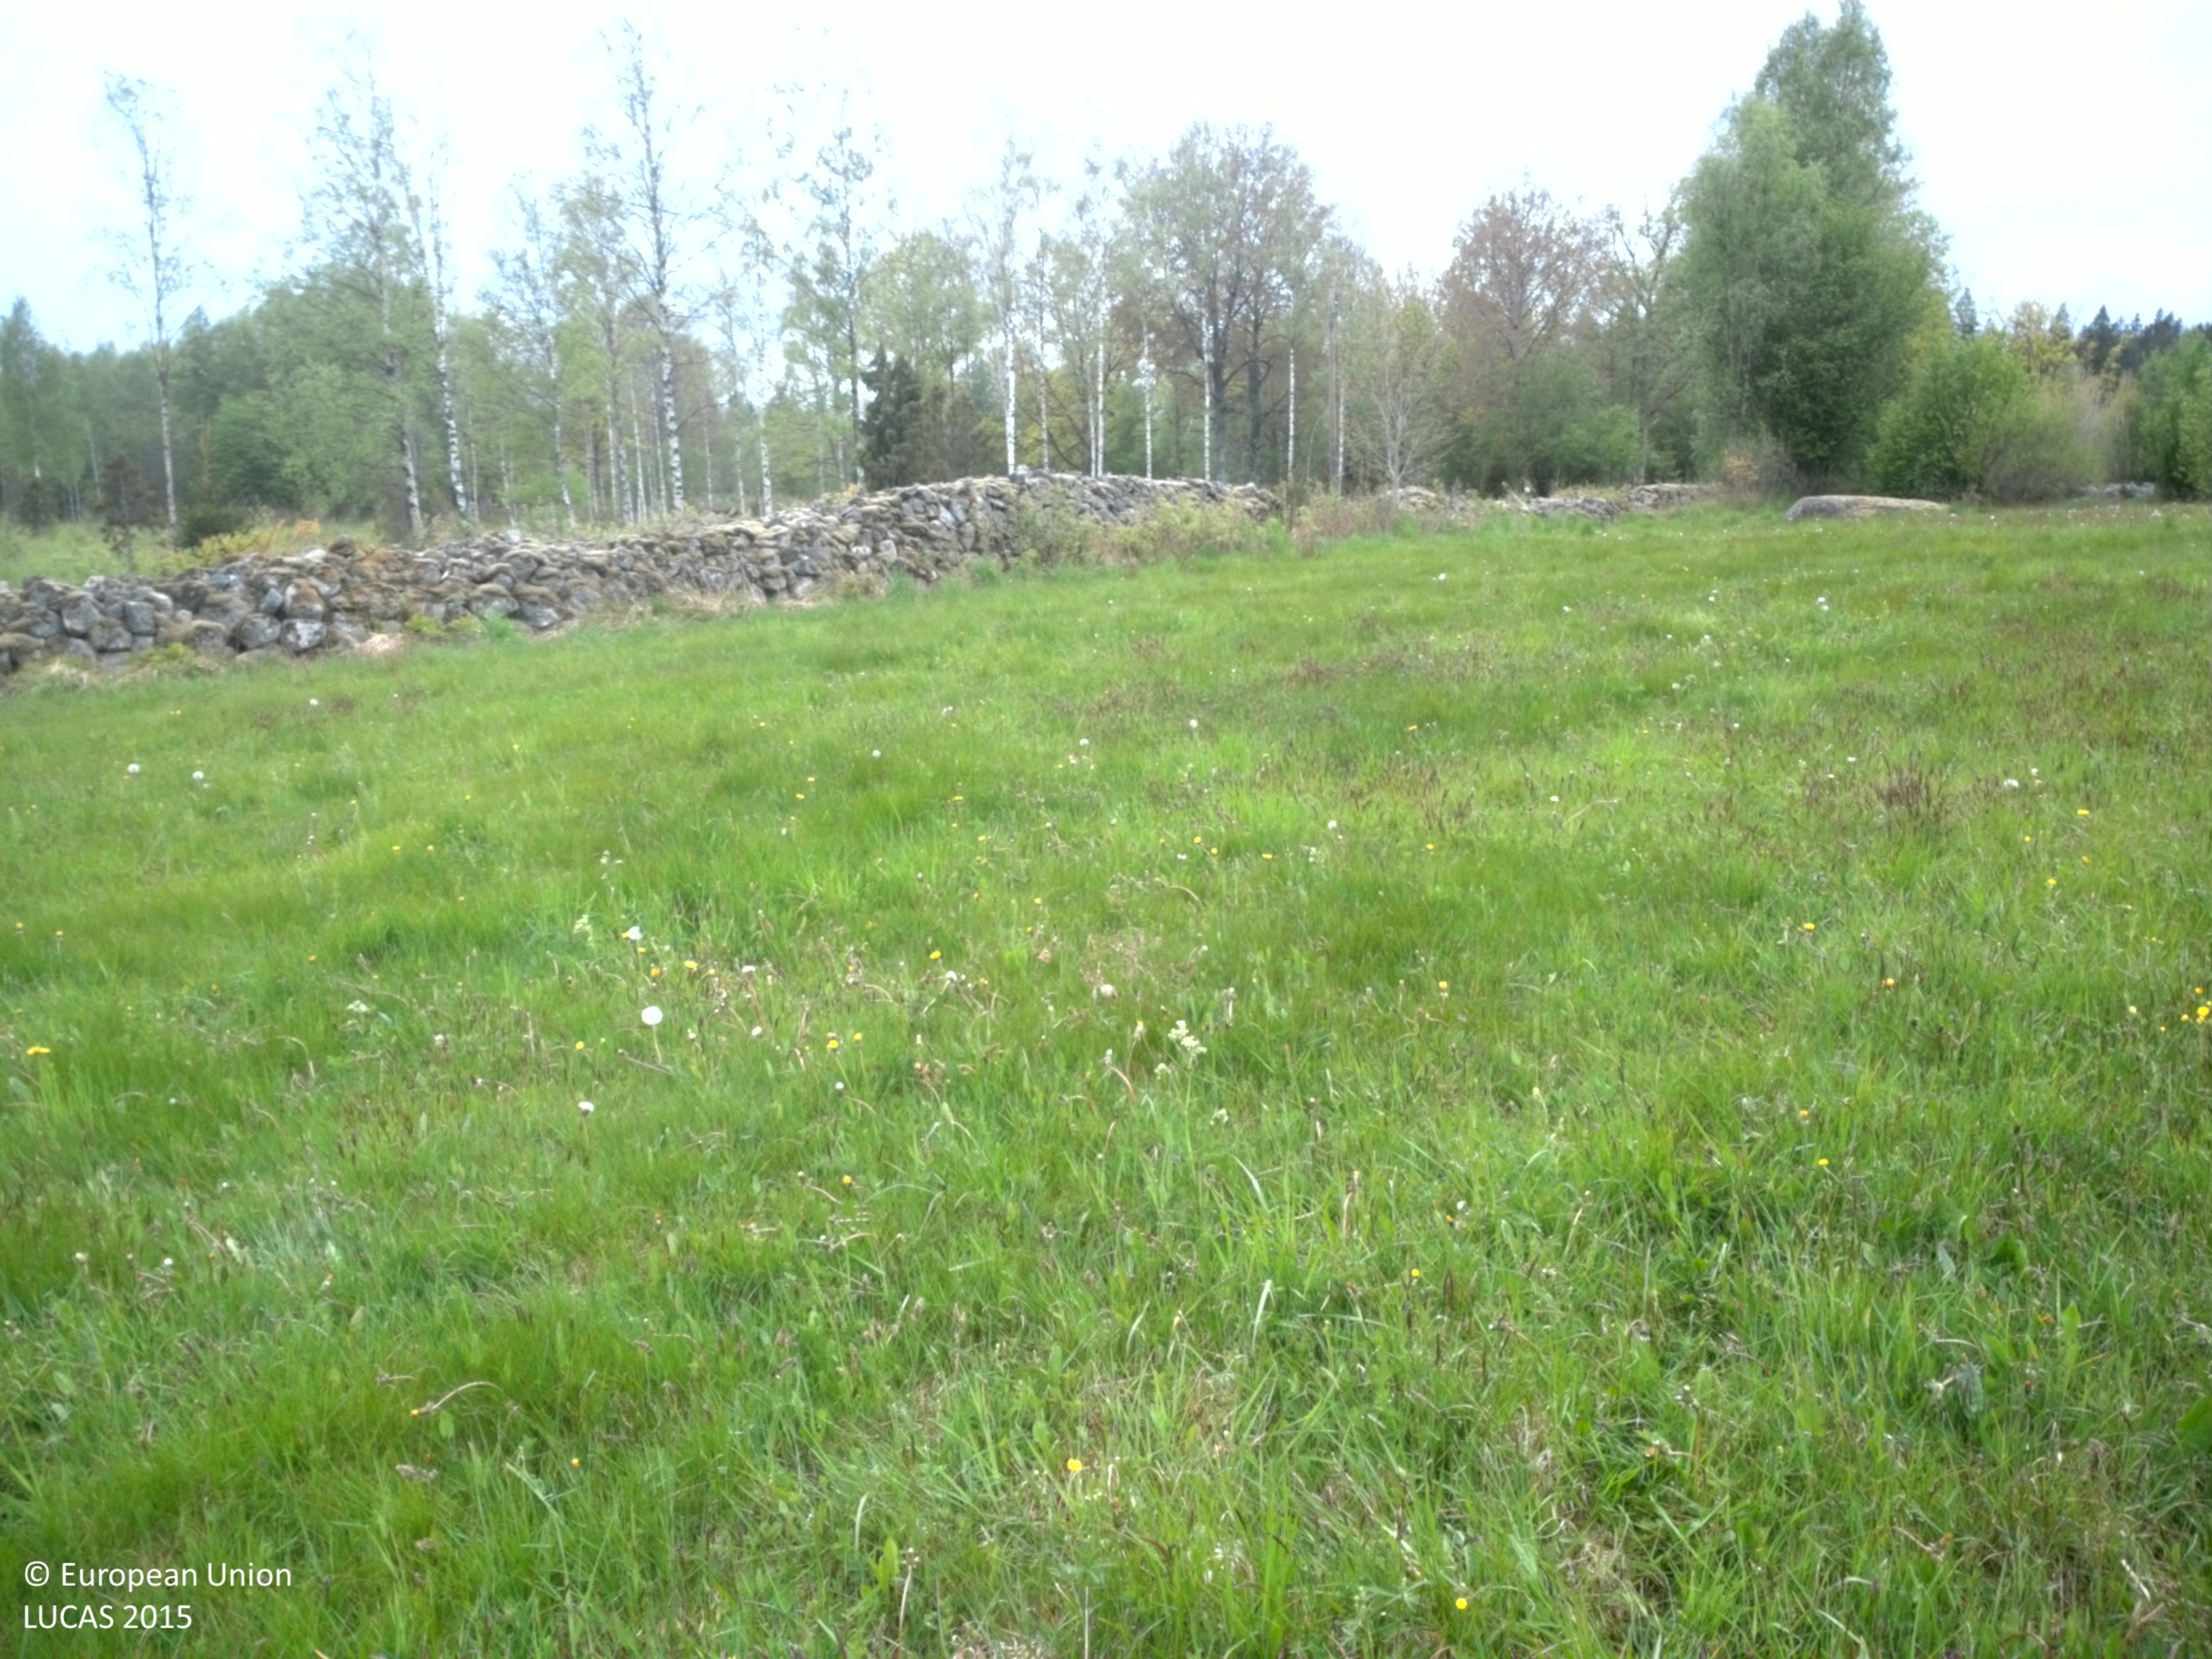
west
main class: Grassland
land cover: Grassland without tree/shrub cover
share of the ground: > 75 %
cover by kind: herbaceous plants 100 %
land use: Agriculture (excluding fallow land and kitchen gardens)
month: May
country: SE
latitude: 56.5706
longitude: 15.1576
